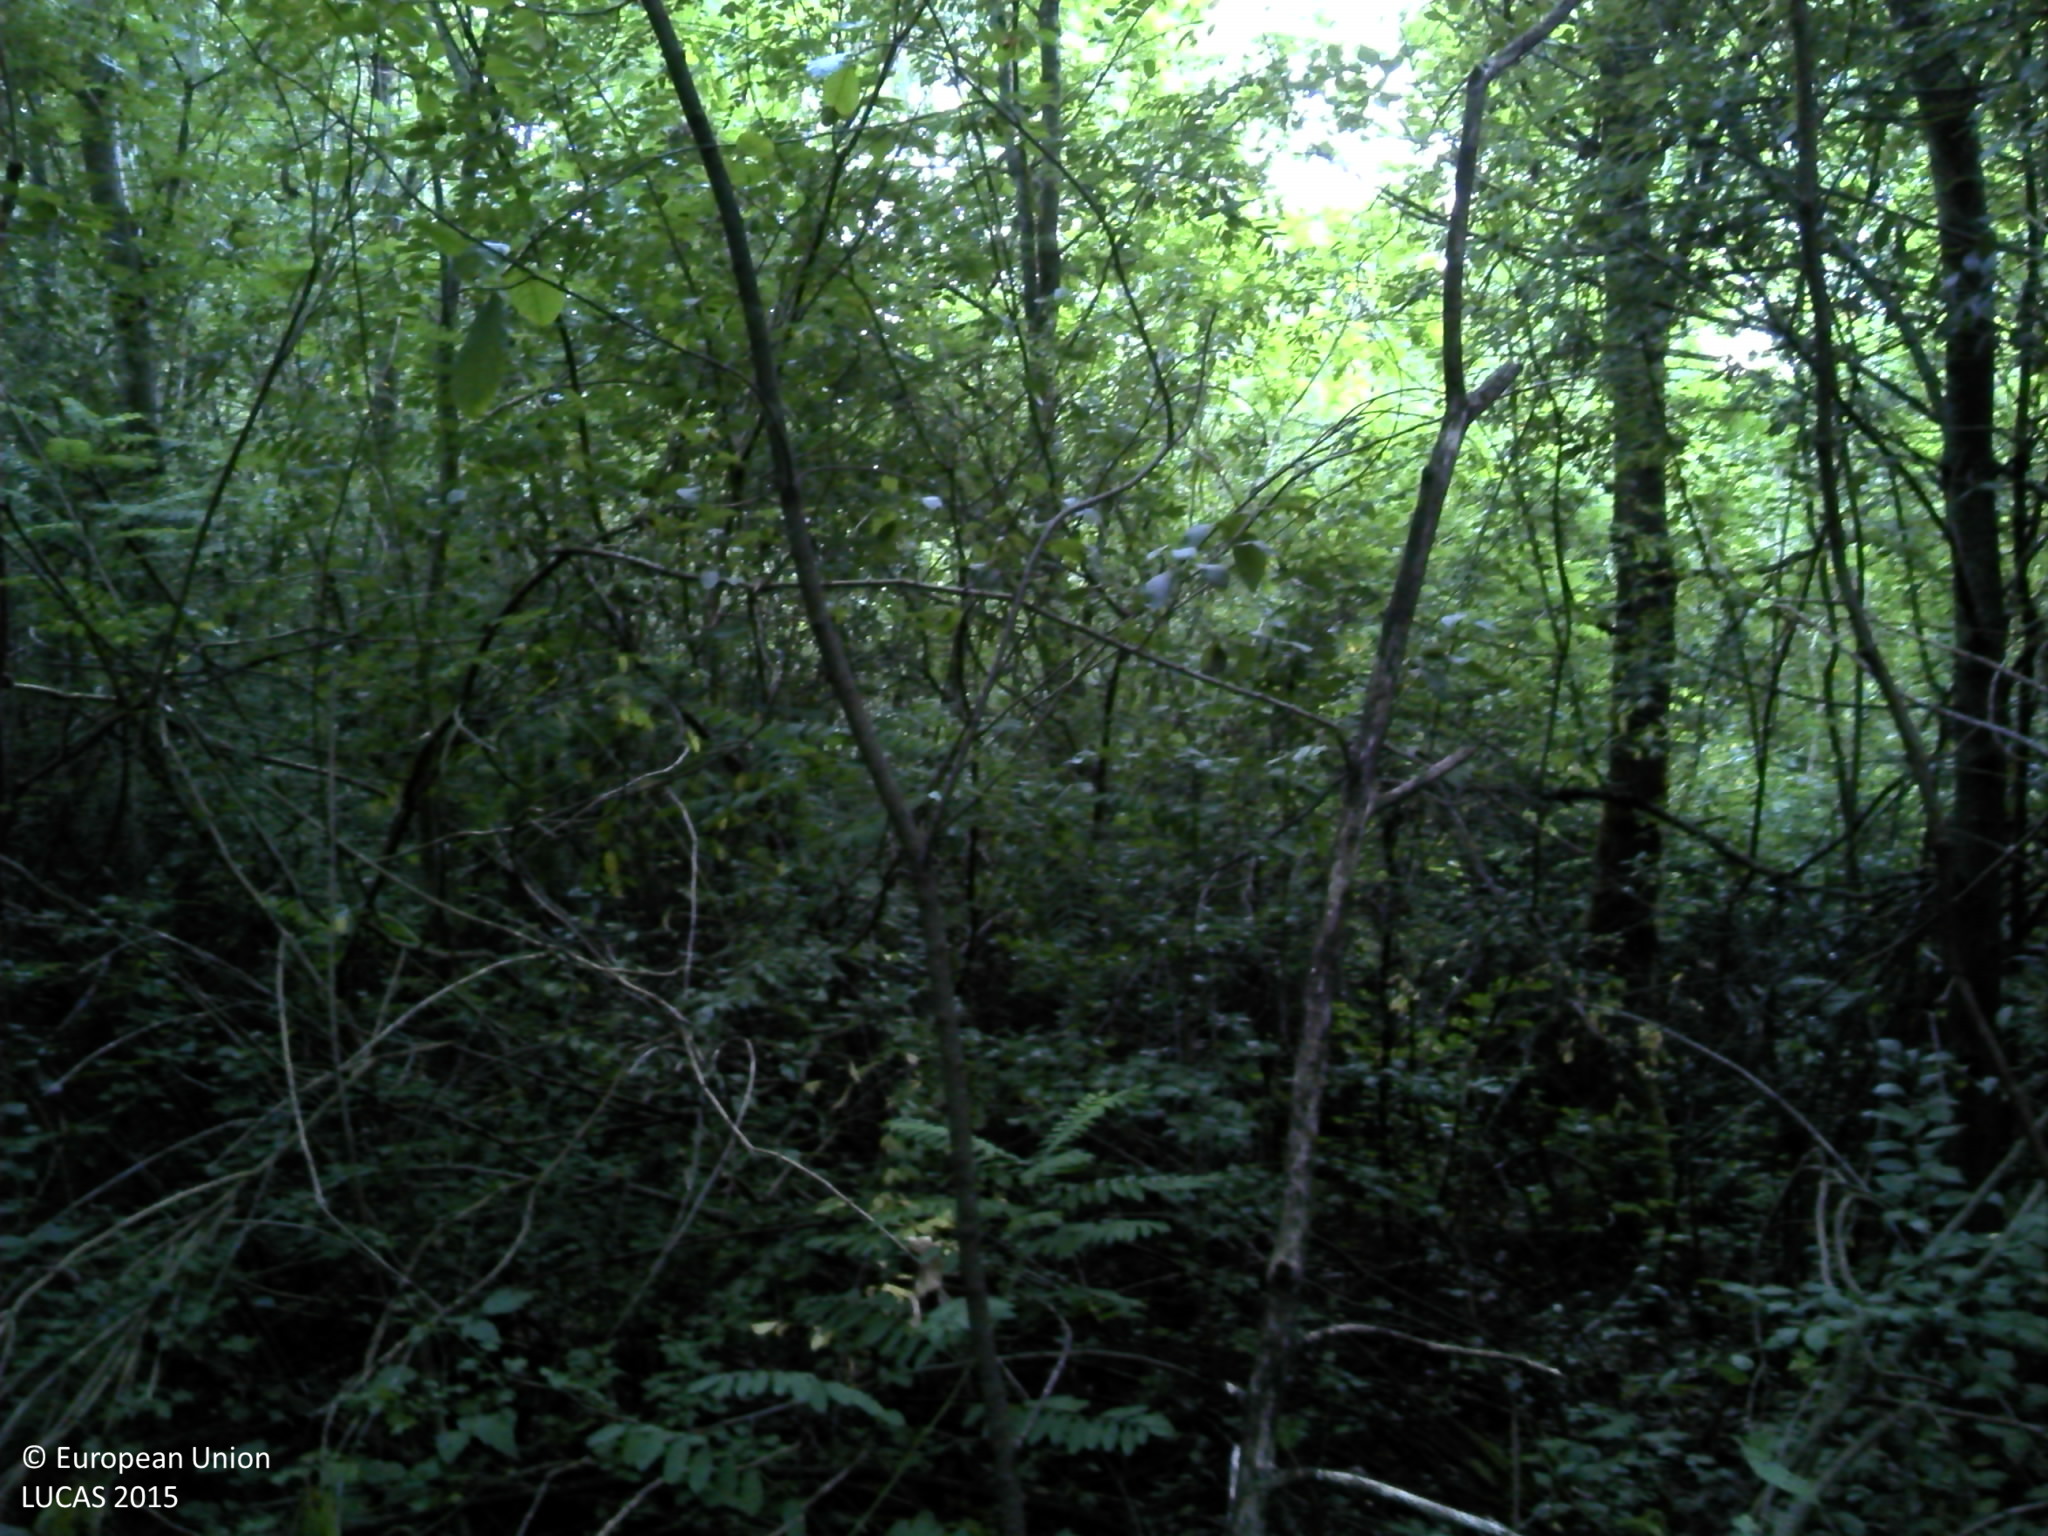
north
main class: Shrubland
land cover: Shrubland with sparse tree cover
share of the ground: > 75 %
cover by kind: shrubs 95 %, broadleaved forest trees 5 %
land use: Semi-natural and natural areas not in use
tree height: < 5 m
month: August
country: HR
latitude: 45.4288
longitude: 16.5294
